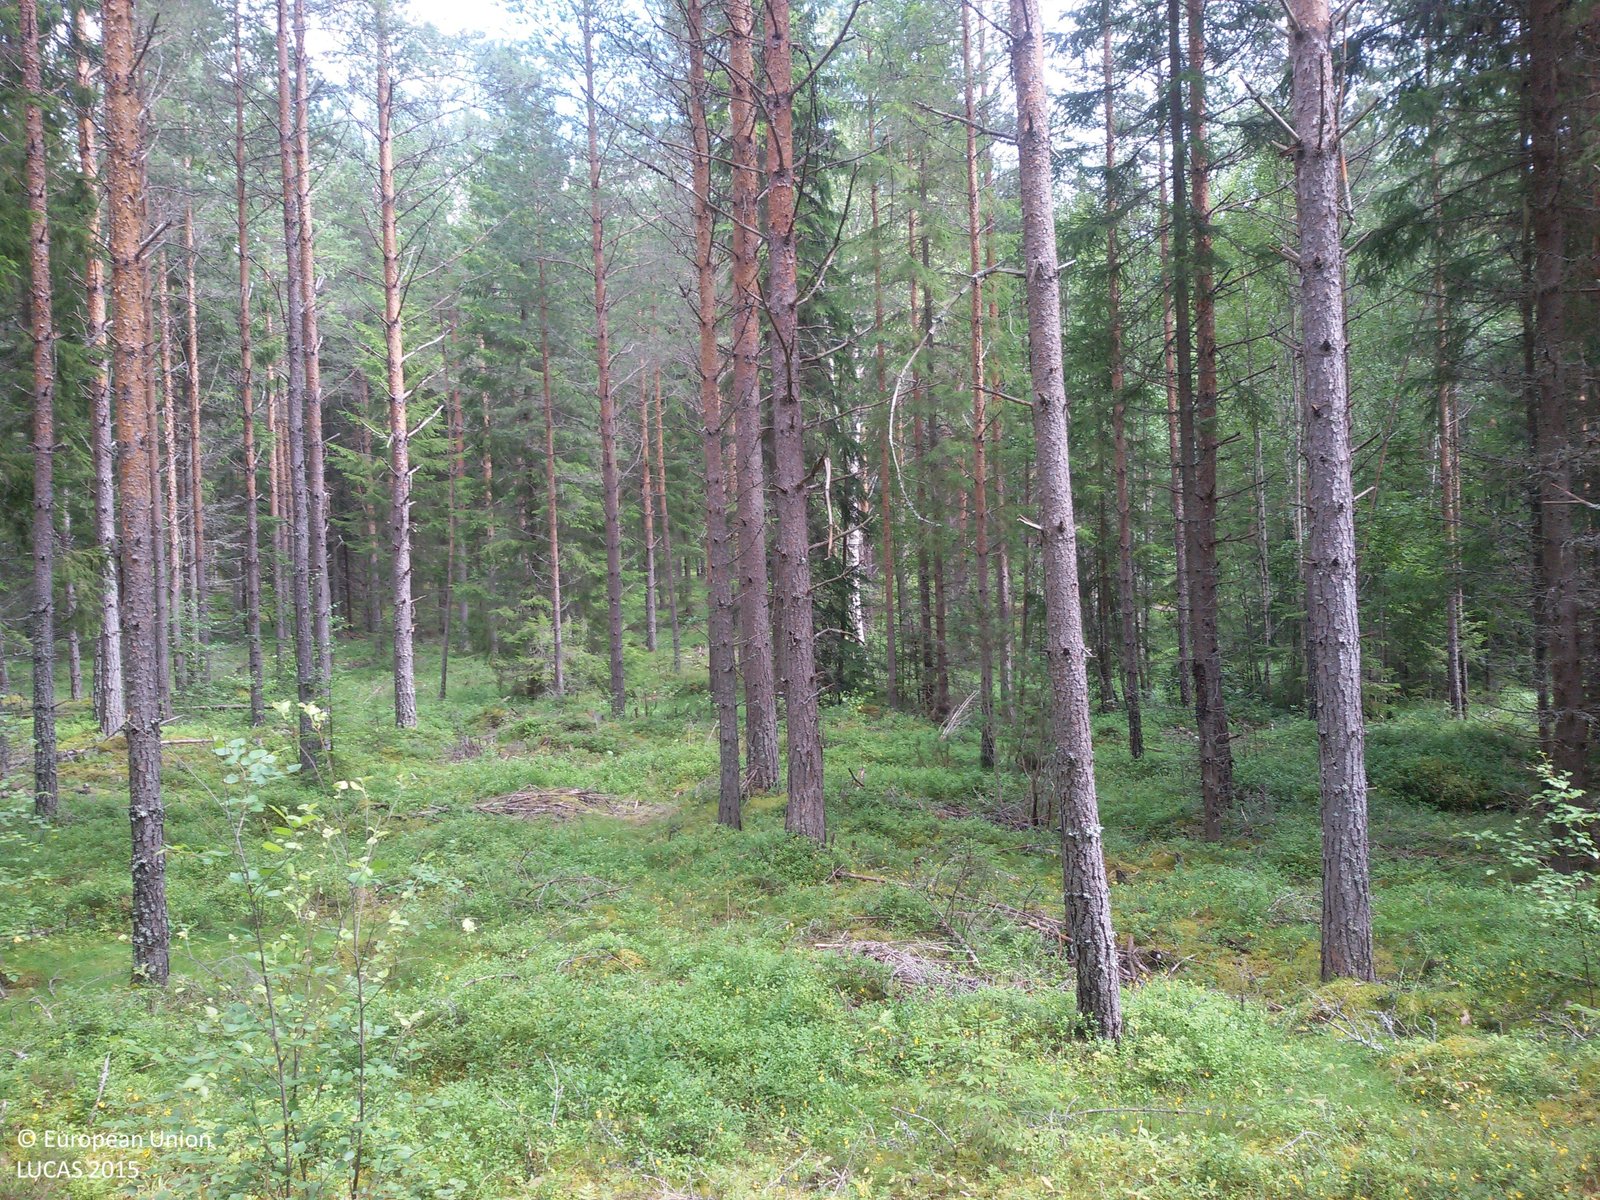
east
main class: Woodland
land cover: Pine dominated coniferous woodland
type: boreal forest
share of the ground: > 75 %
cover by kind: coniferous forest trees 75 %, shrubs 25 %
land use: Forestry
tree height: > 5 m
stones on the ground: > 50 %
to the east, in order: Pine dominated coniferous woodland; Tracks; Pine dominated coniferous woodland
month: July
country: SE
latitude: 60.4921
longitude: 15.8668
